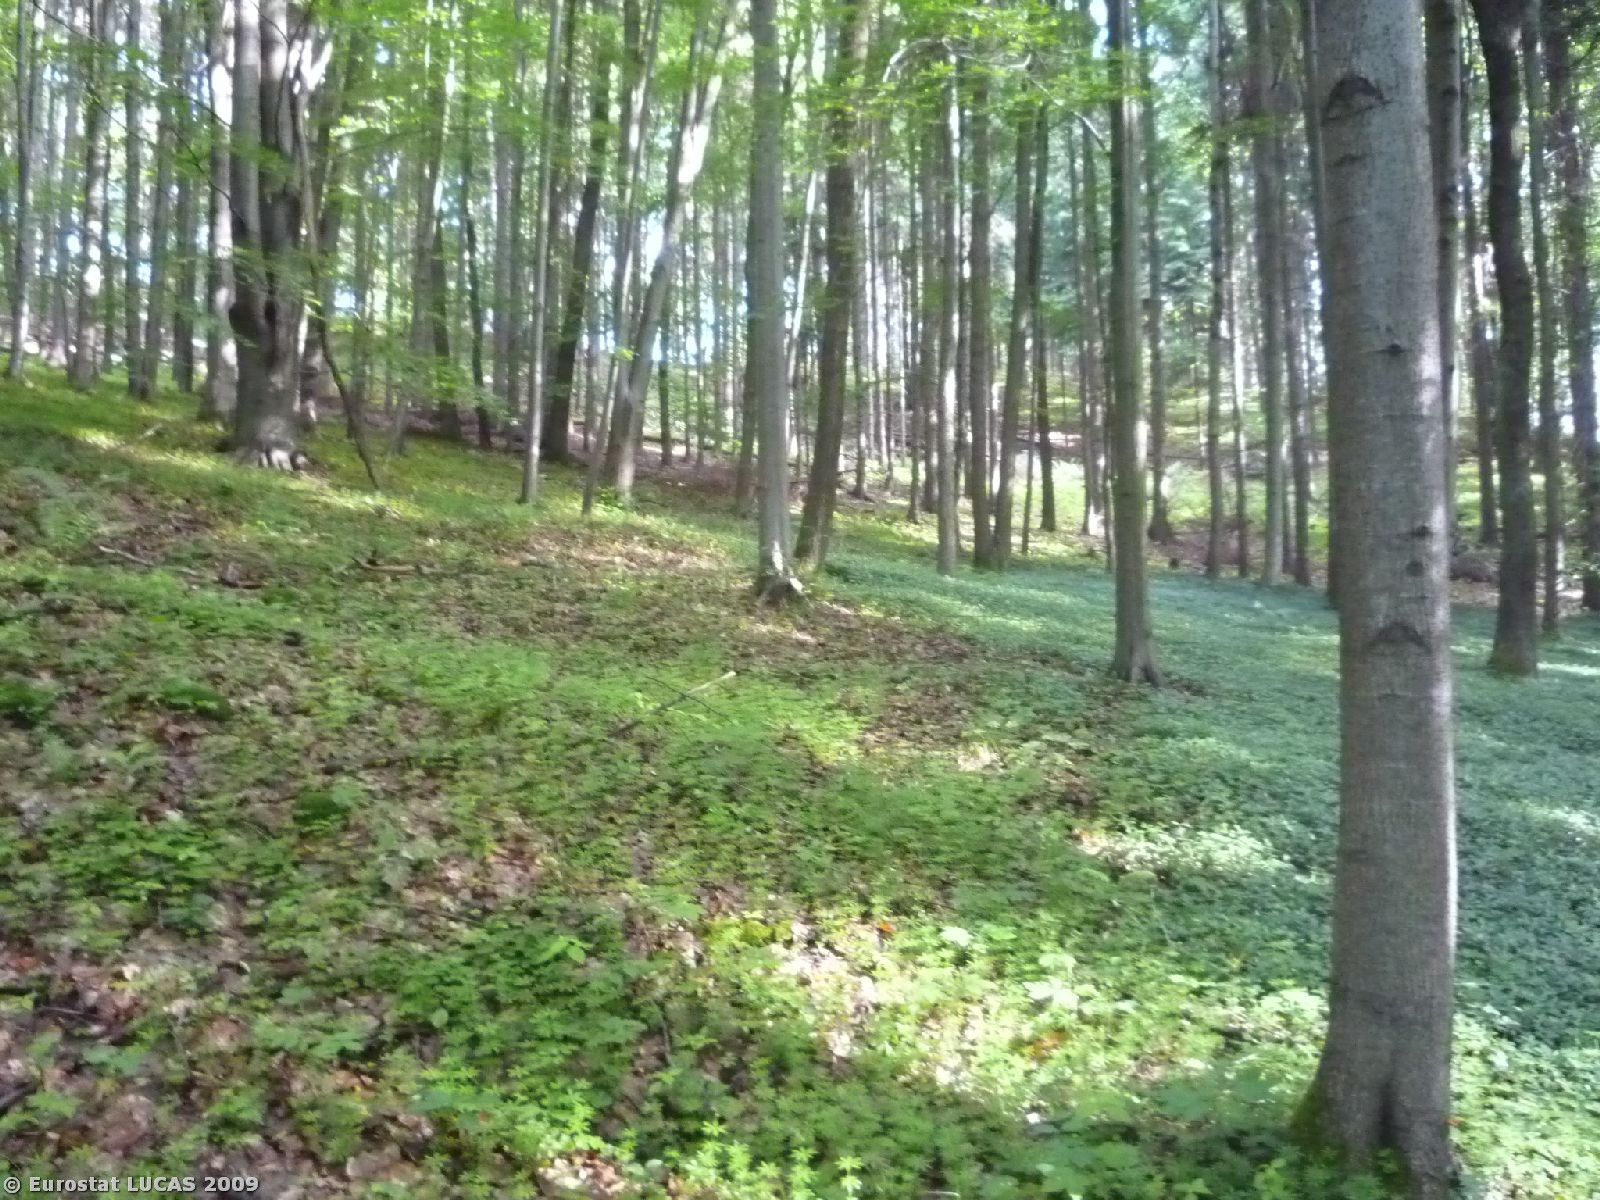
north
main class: Woodland
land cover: Broadleaved woodland
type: beech forest
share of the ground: > 75 %
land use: Forestry
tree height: > 5 m
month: June
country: CZ
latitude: 50.4489
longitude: 15.4824
